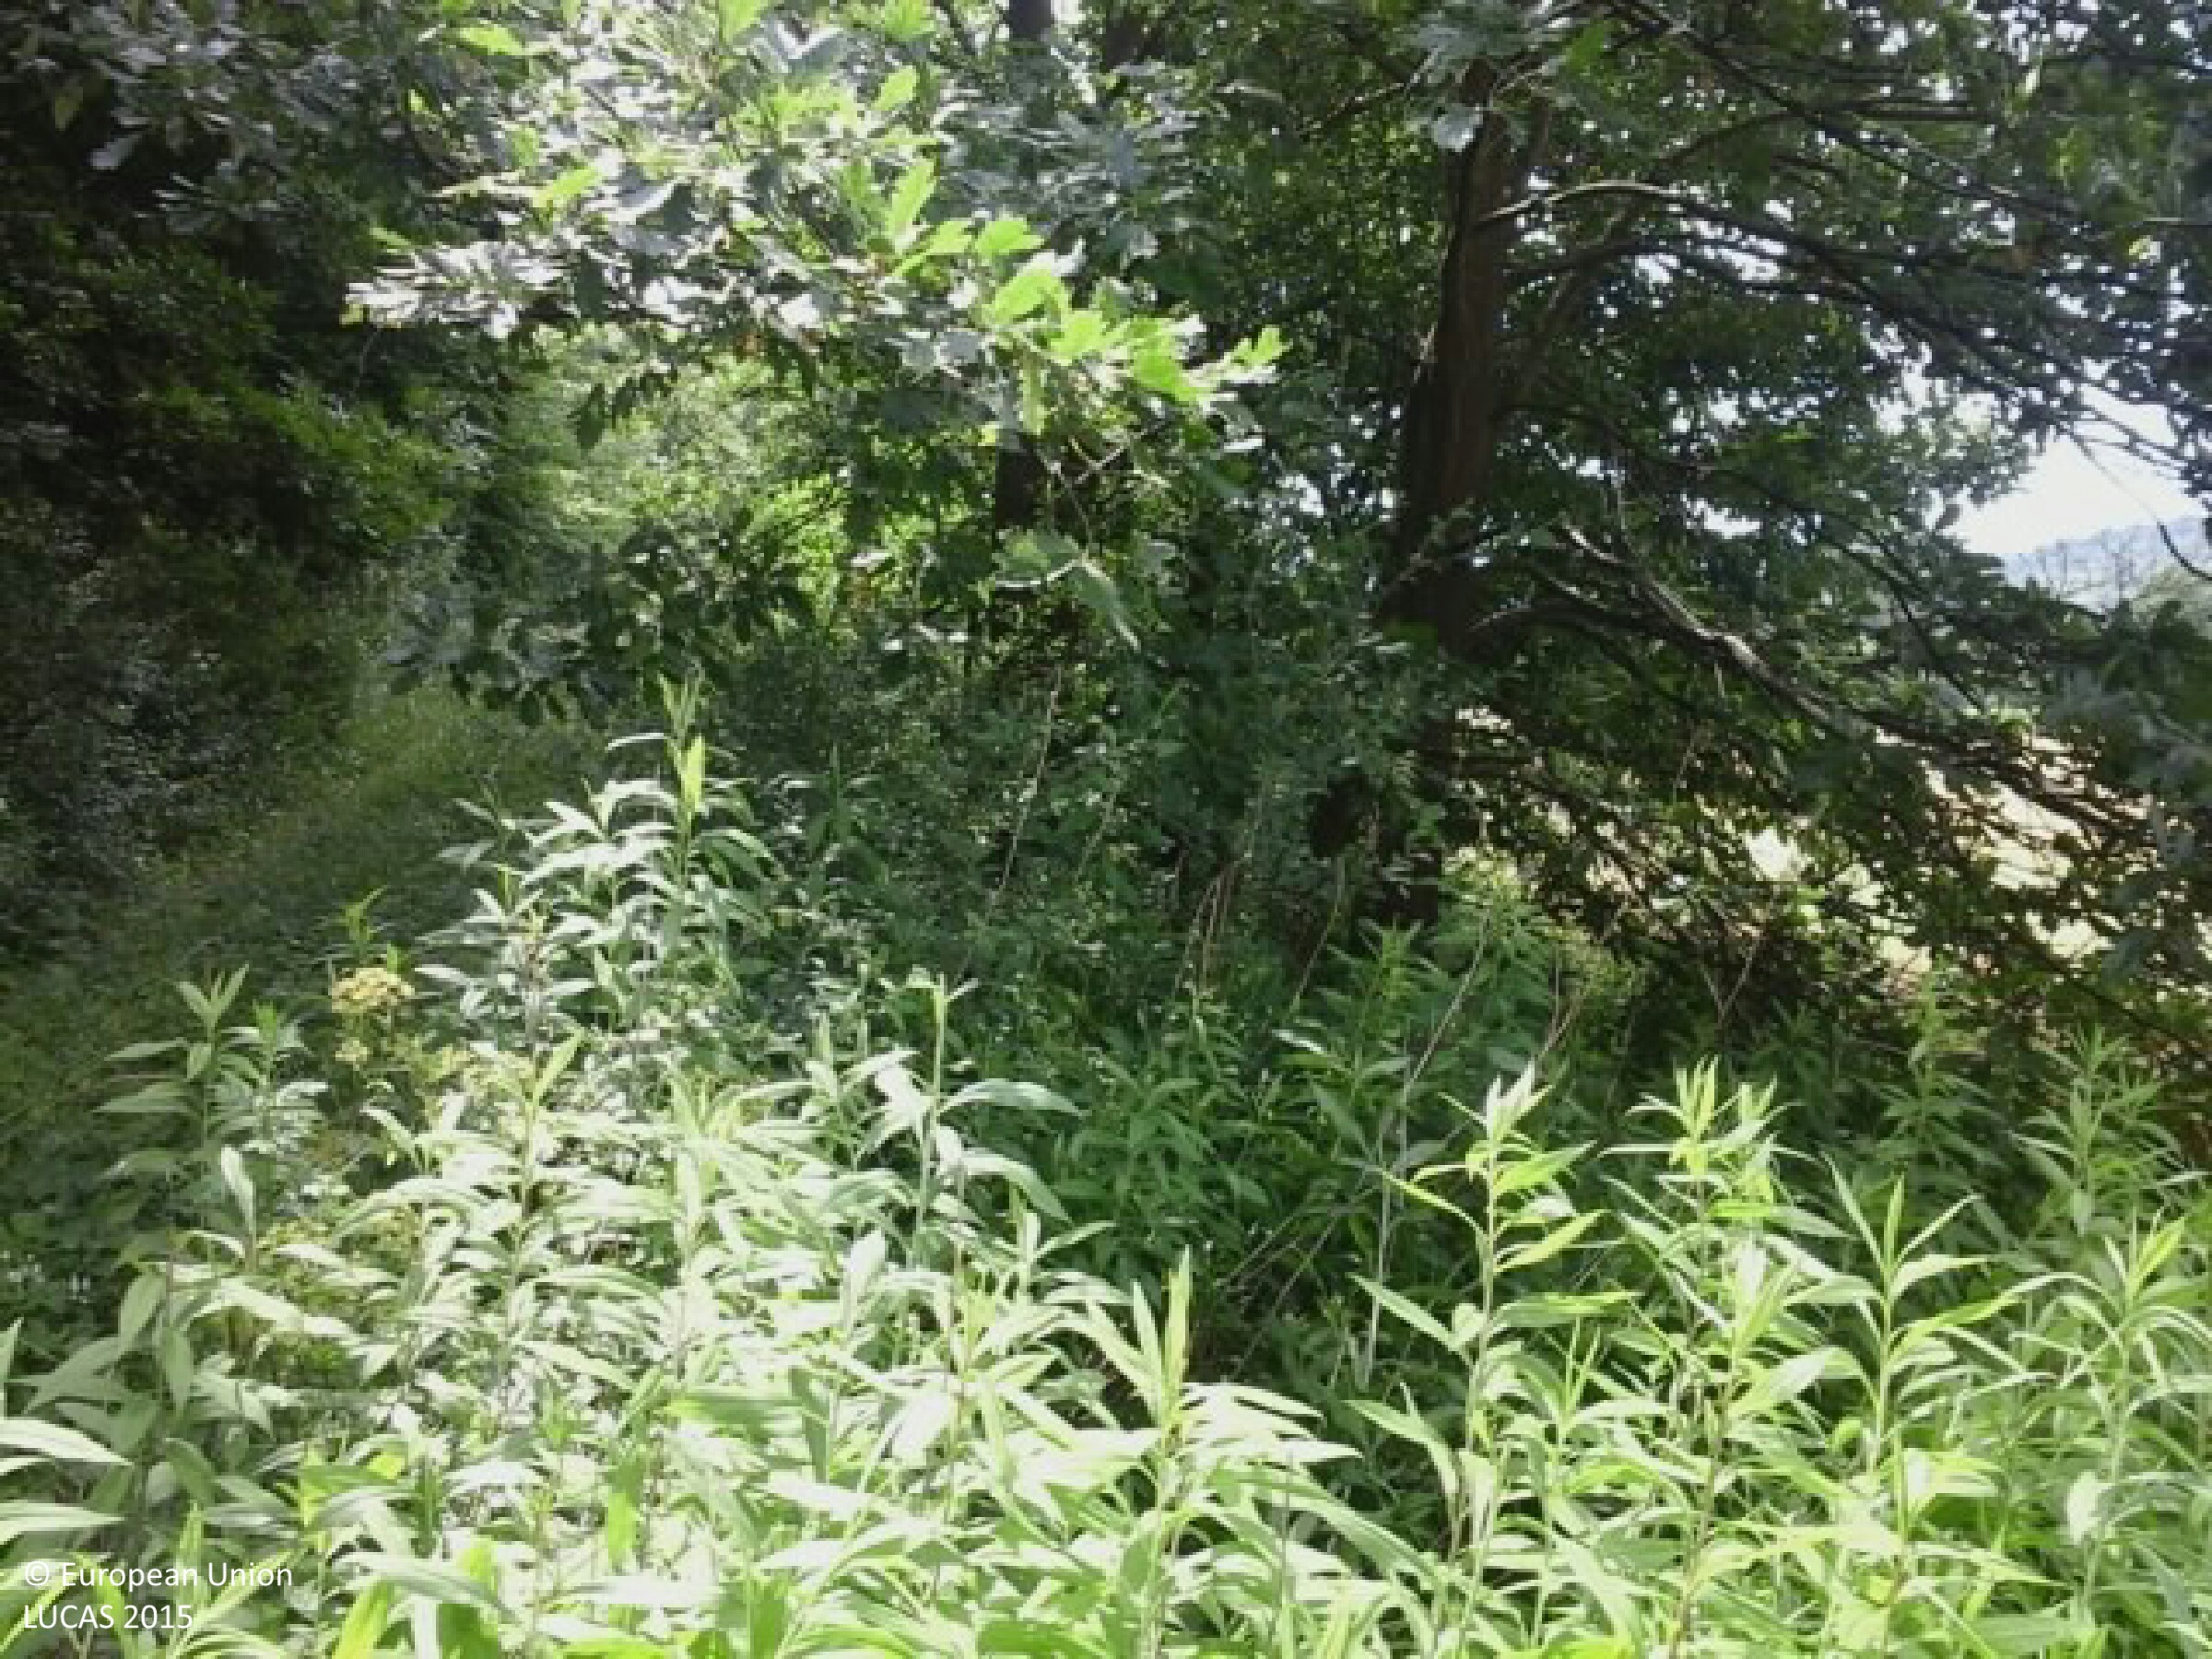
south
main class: Grassland
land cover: Spontaneously vegetated surfaces
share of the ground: > 75 %
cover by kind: herbaceous plants 100 %
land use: Semi-natural and natural areas not in use
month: June
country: HU
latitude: 46.3308
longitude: 17.8912
